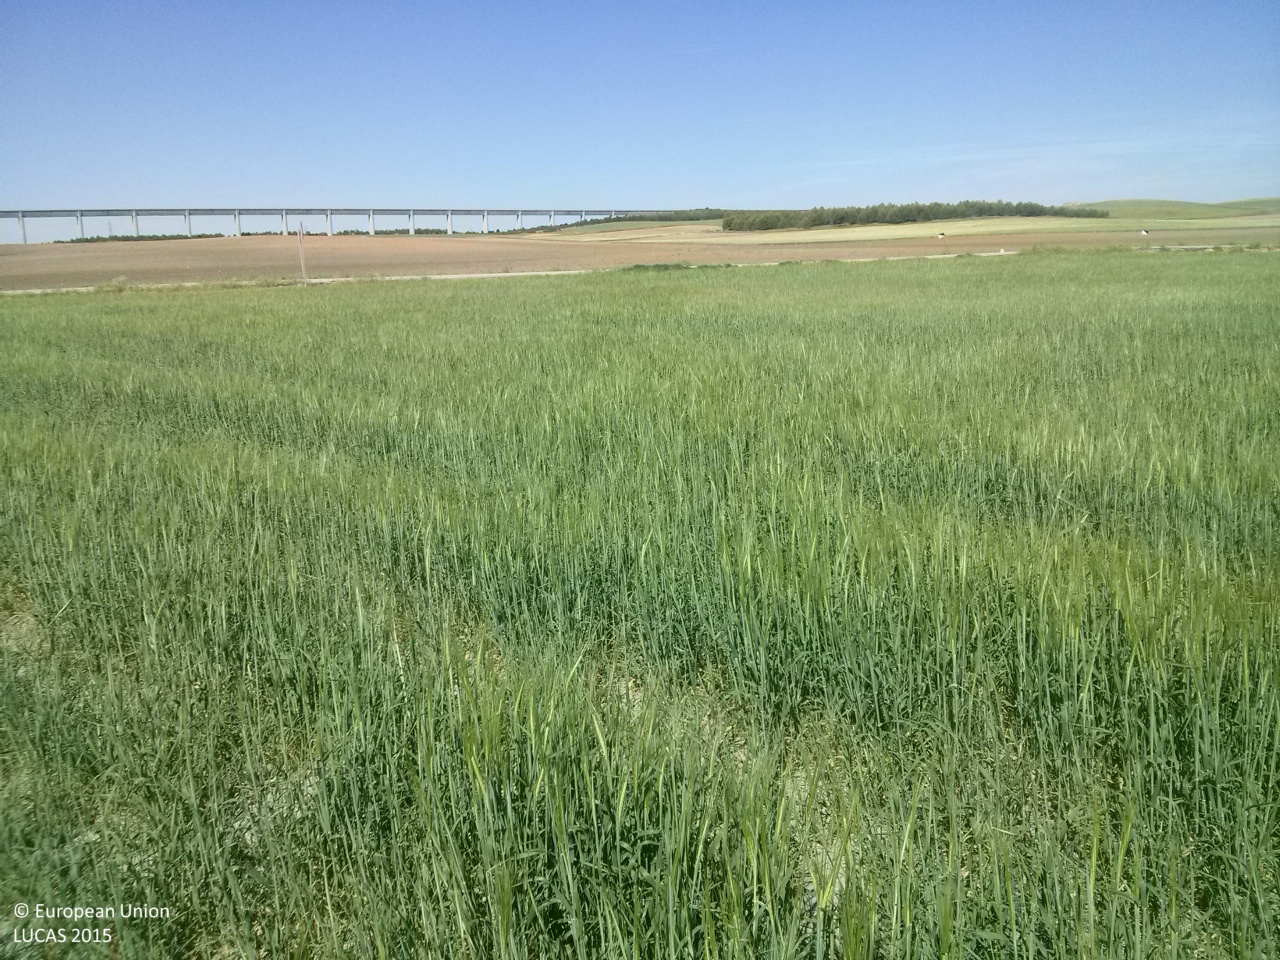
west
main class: Cropland
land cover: Barley
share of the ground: > 75 %
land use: Agriculture (excluding fallow land and kitchen gardens)
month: May
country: ES
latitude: 39.9510
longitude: -2.6962
